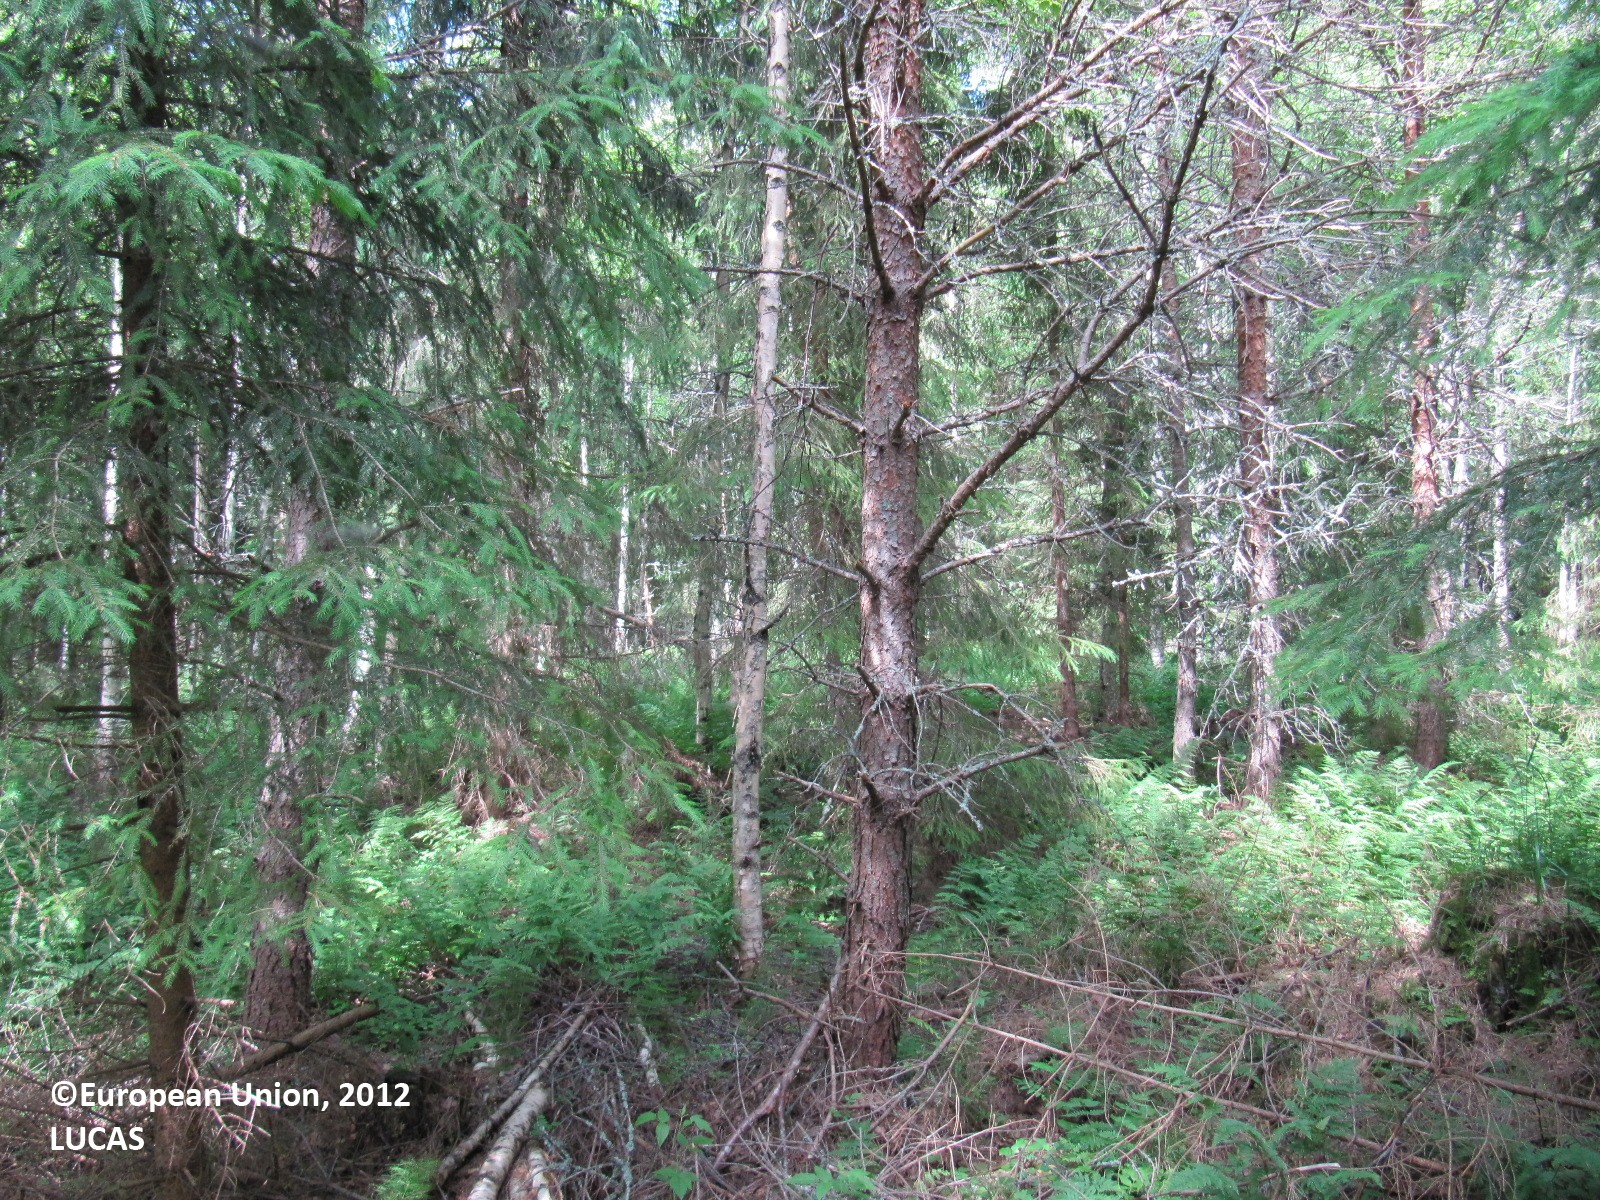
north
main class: Woodland
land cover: Spruce dominated mixed woodland
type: boreal forest
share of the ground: > 75 %
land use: Forestry
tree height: > 5 m
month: July
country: FI
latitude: 60.8806
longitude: 23.3262
